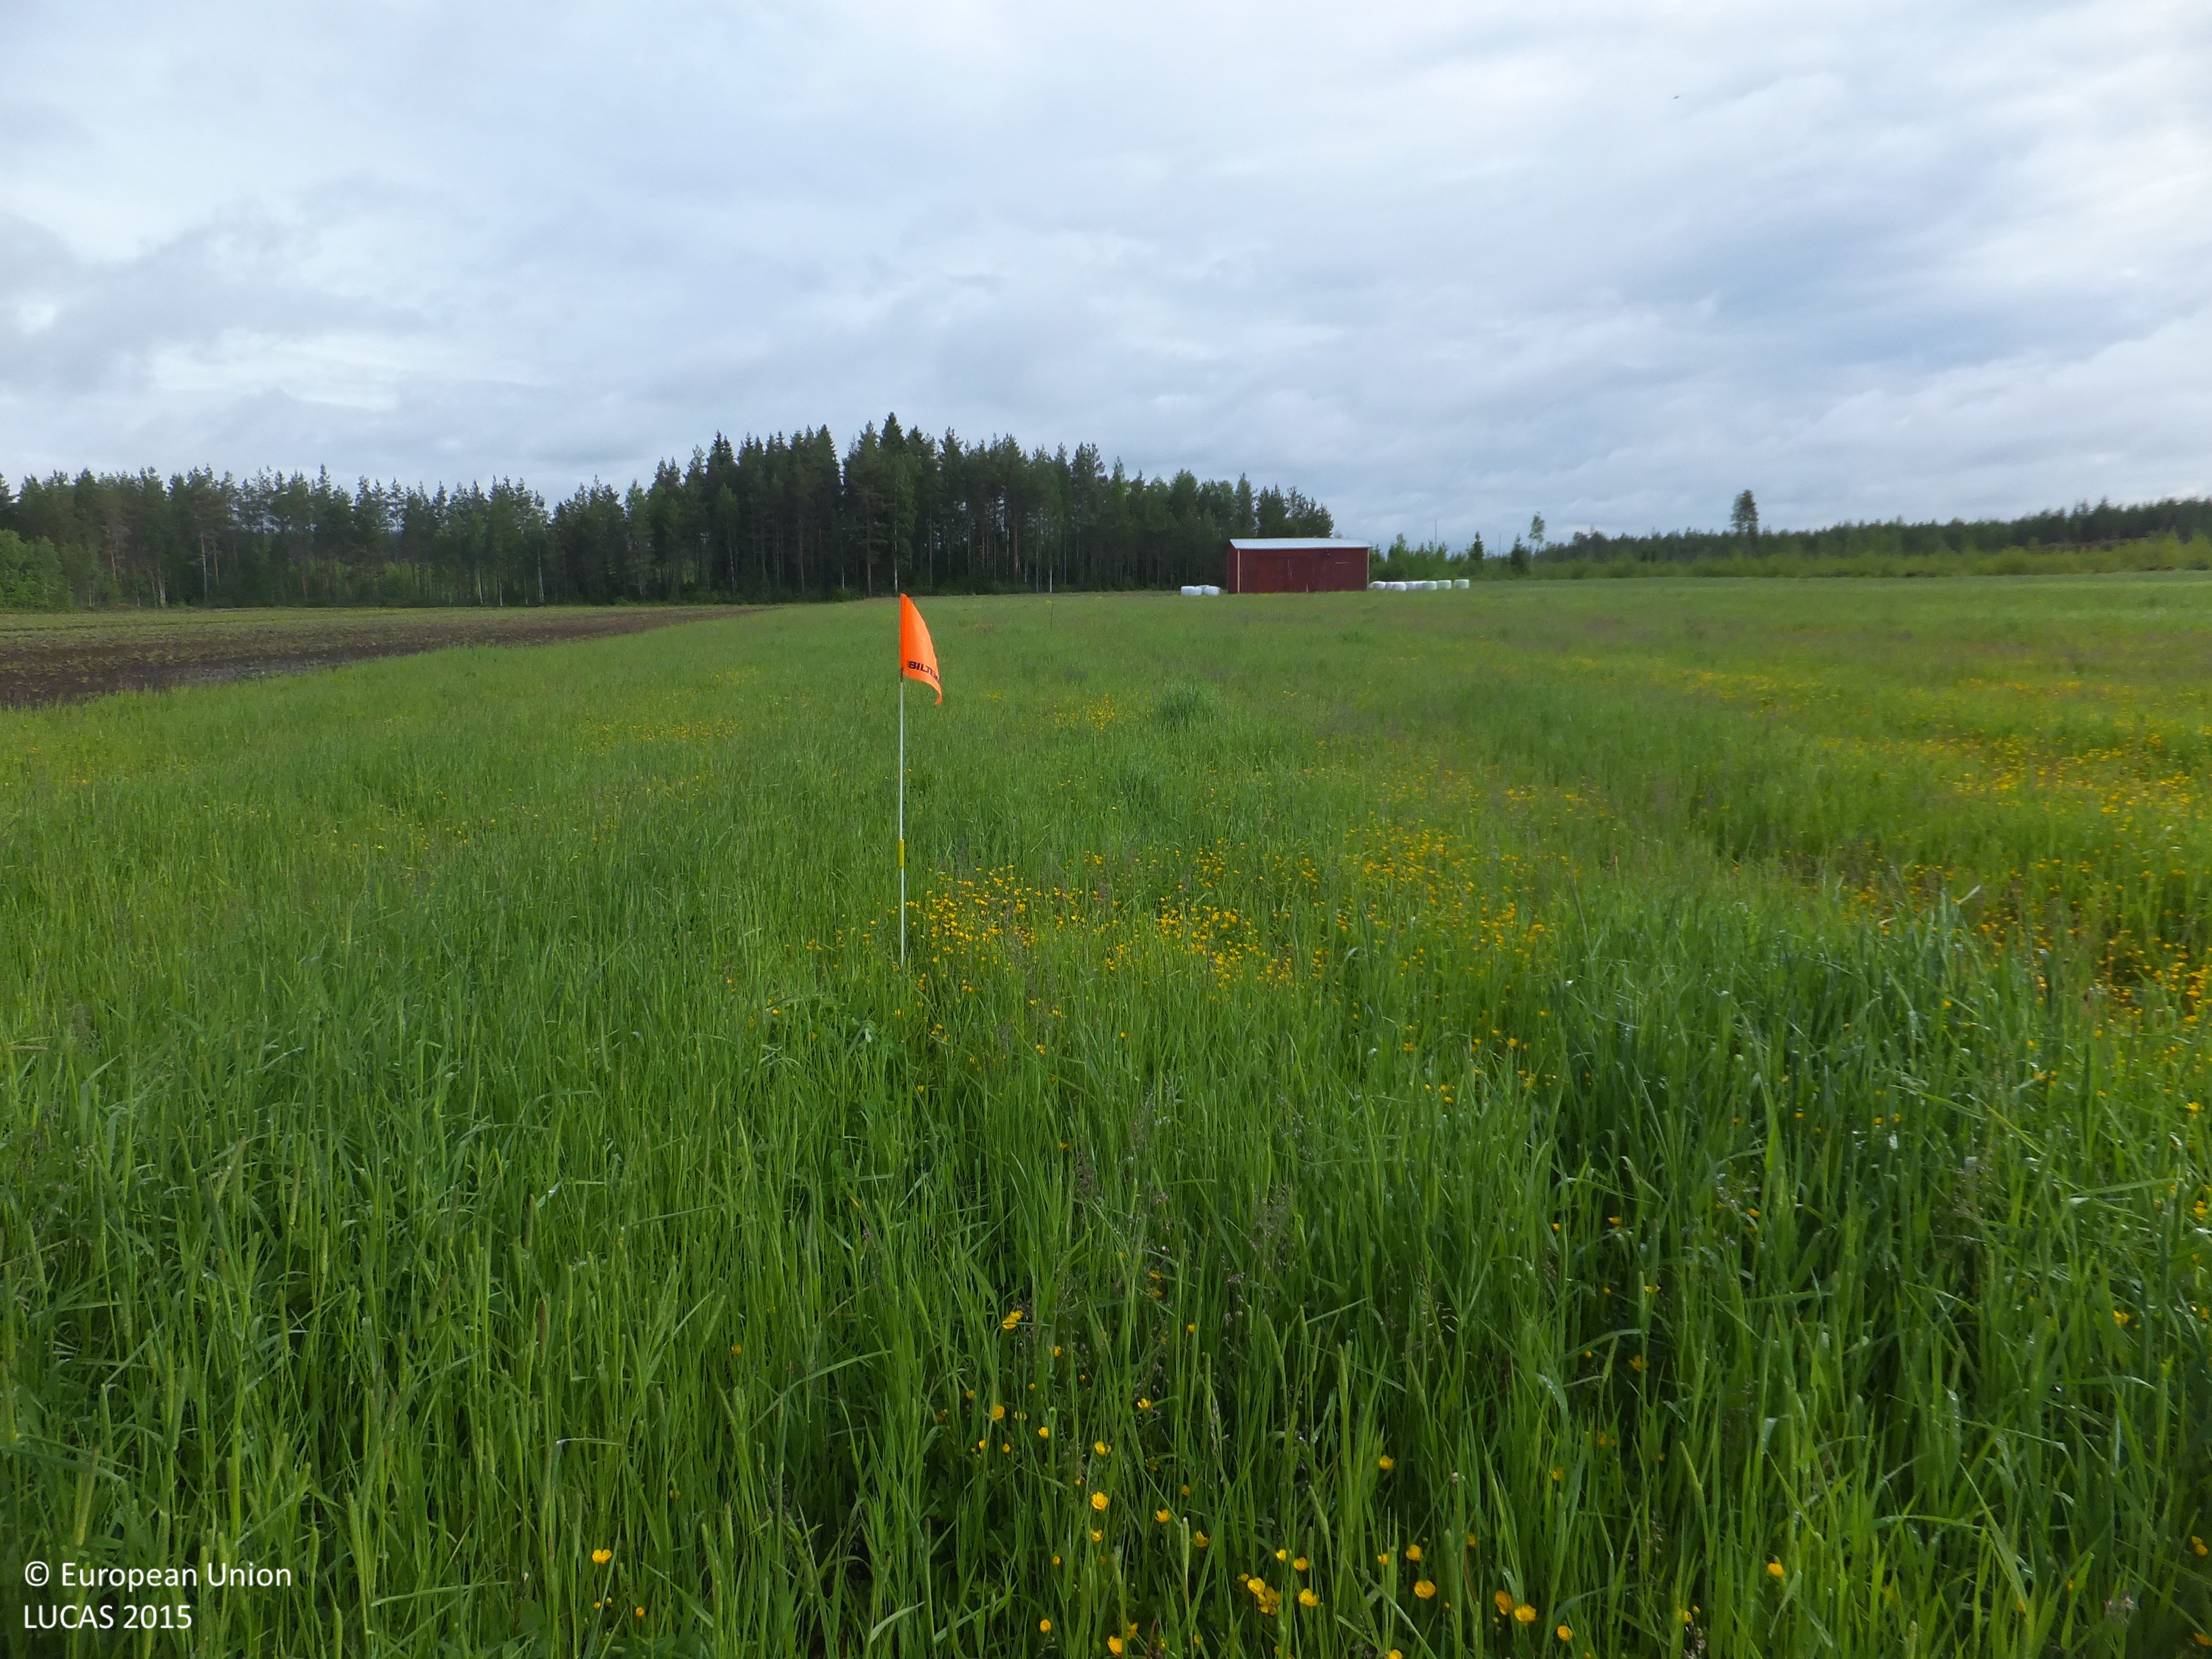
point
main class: Cropland
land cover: Temporary grasslands
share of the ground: > 75 %
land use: Agriculture (excluding fallow land and kitchen gardens)
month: June
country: FI
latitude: 63.3680
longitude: 24.0090
